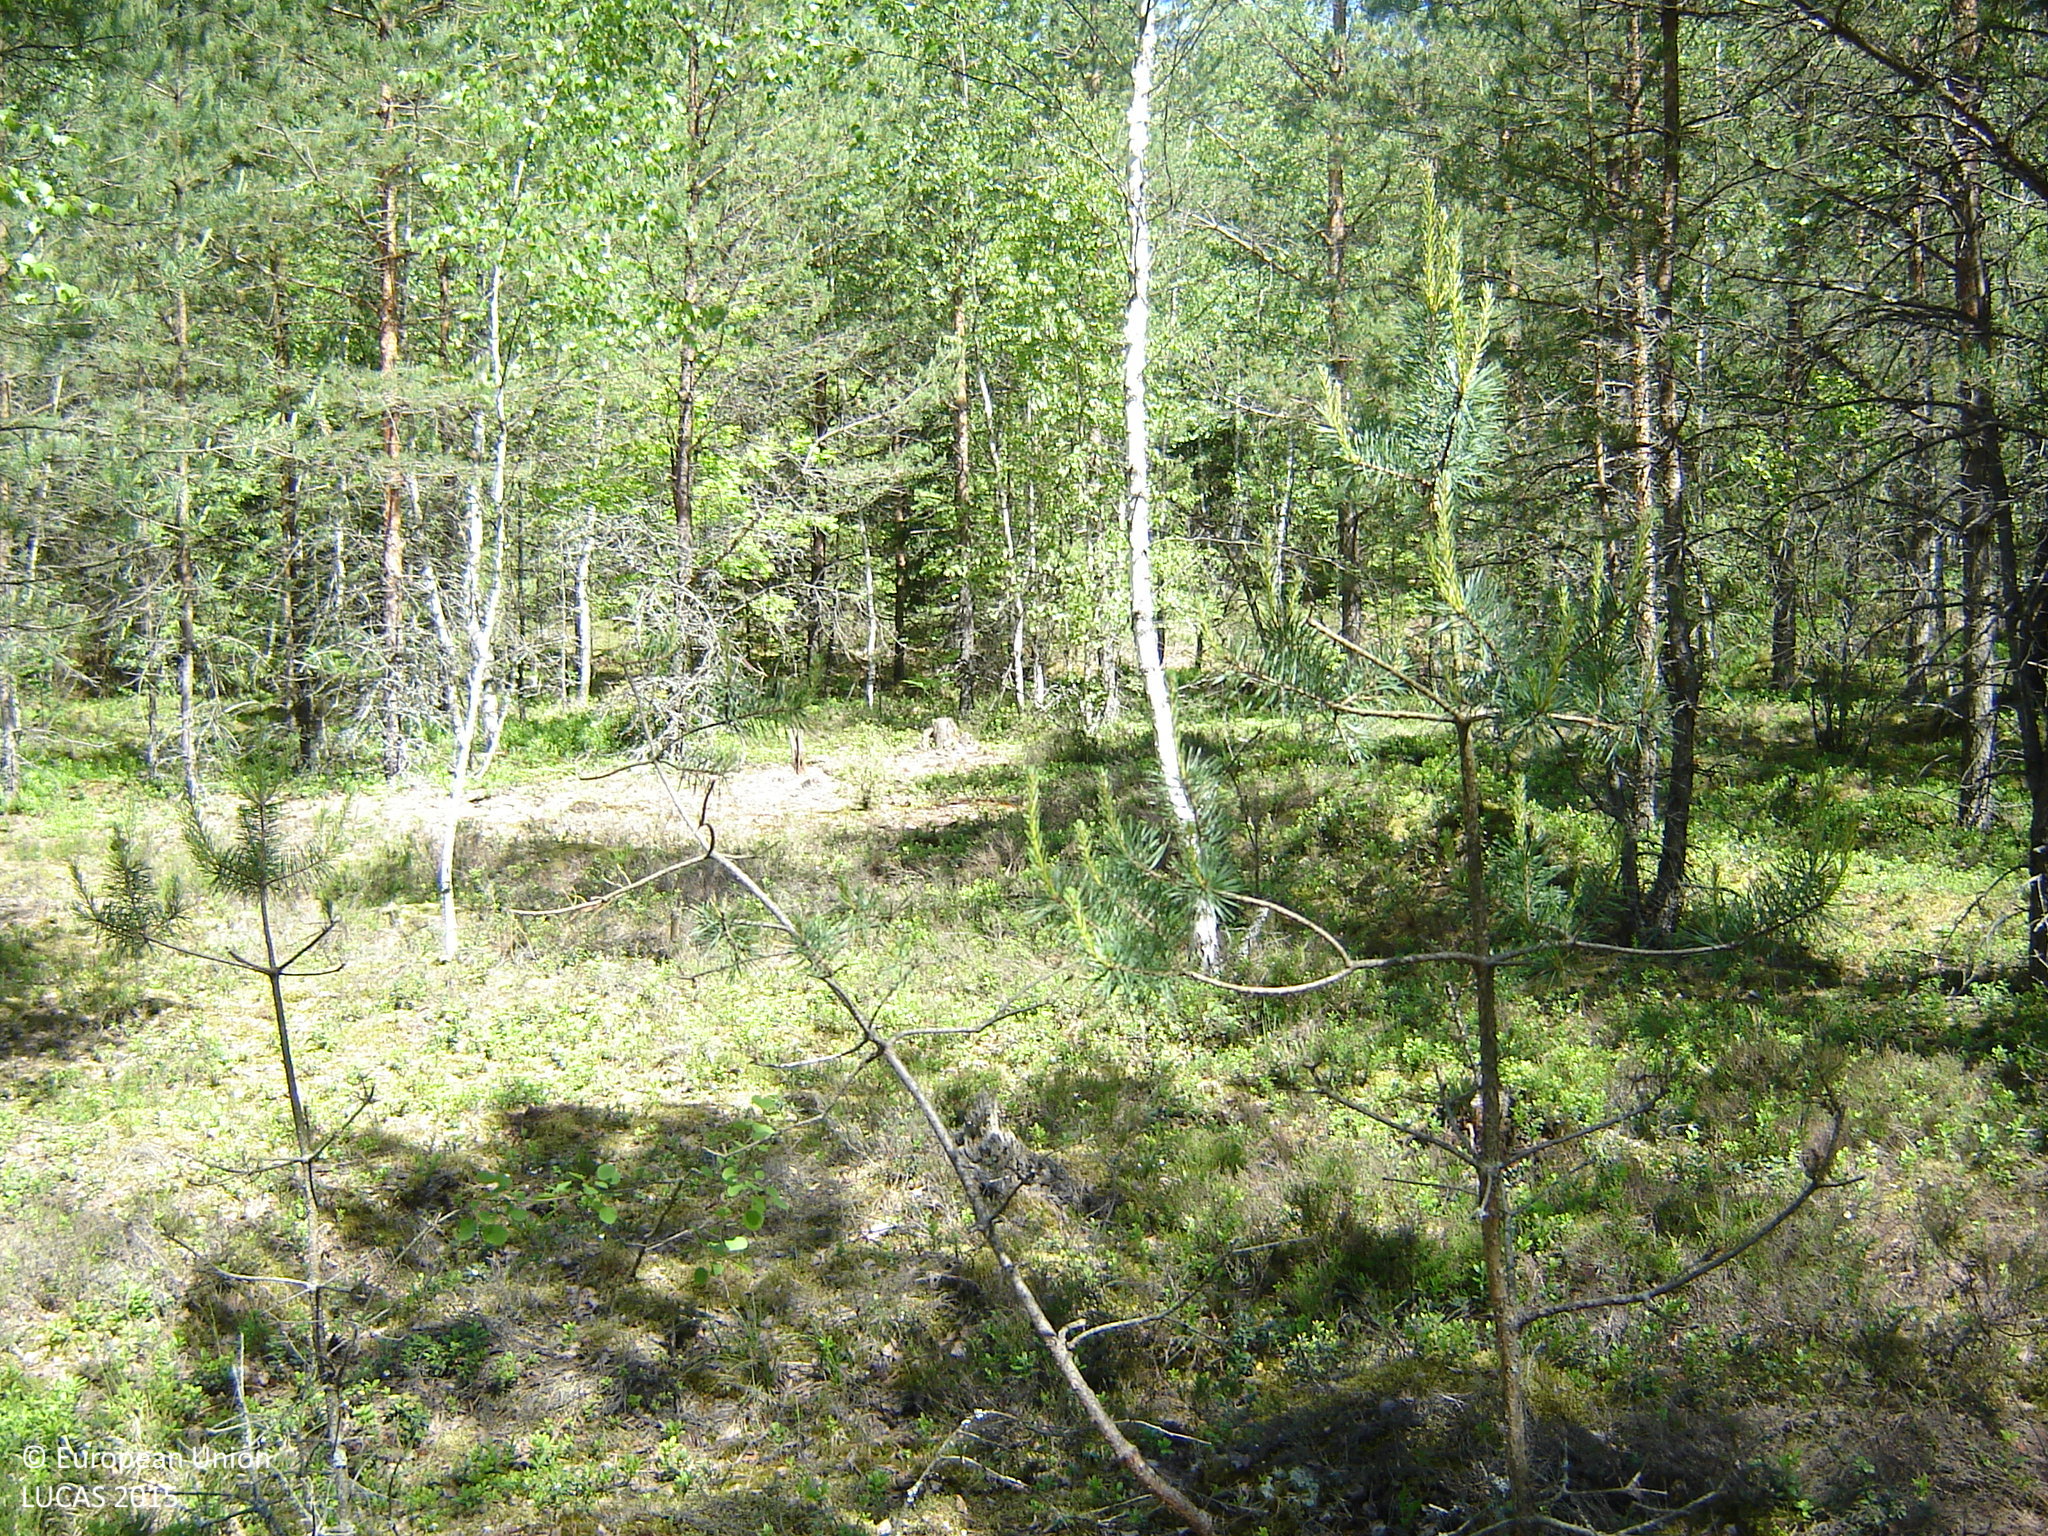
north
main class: Woodland
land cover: Pine dominated coniferous woodland
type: hemiboreal forest and nemoral coniferous forest and mixed broadleaved-coniferous forest
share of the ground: > 75 %
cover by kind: coniferous forest trees 75 %, shrubs 10 %, lichens and mosses 10 %, broadleaved forest trees 5 %
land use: Forestry
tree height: > 5 m
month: June
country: LT
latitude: 55.6357
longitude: 25.0936
